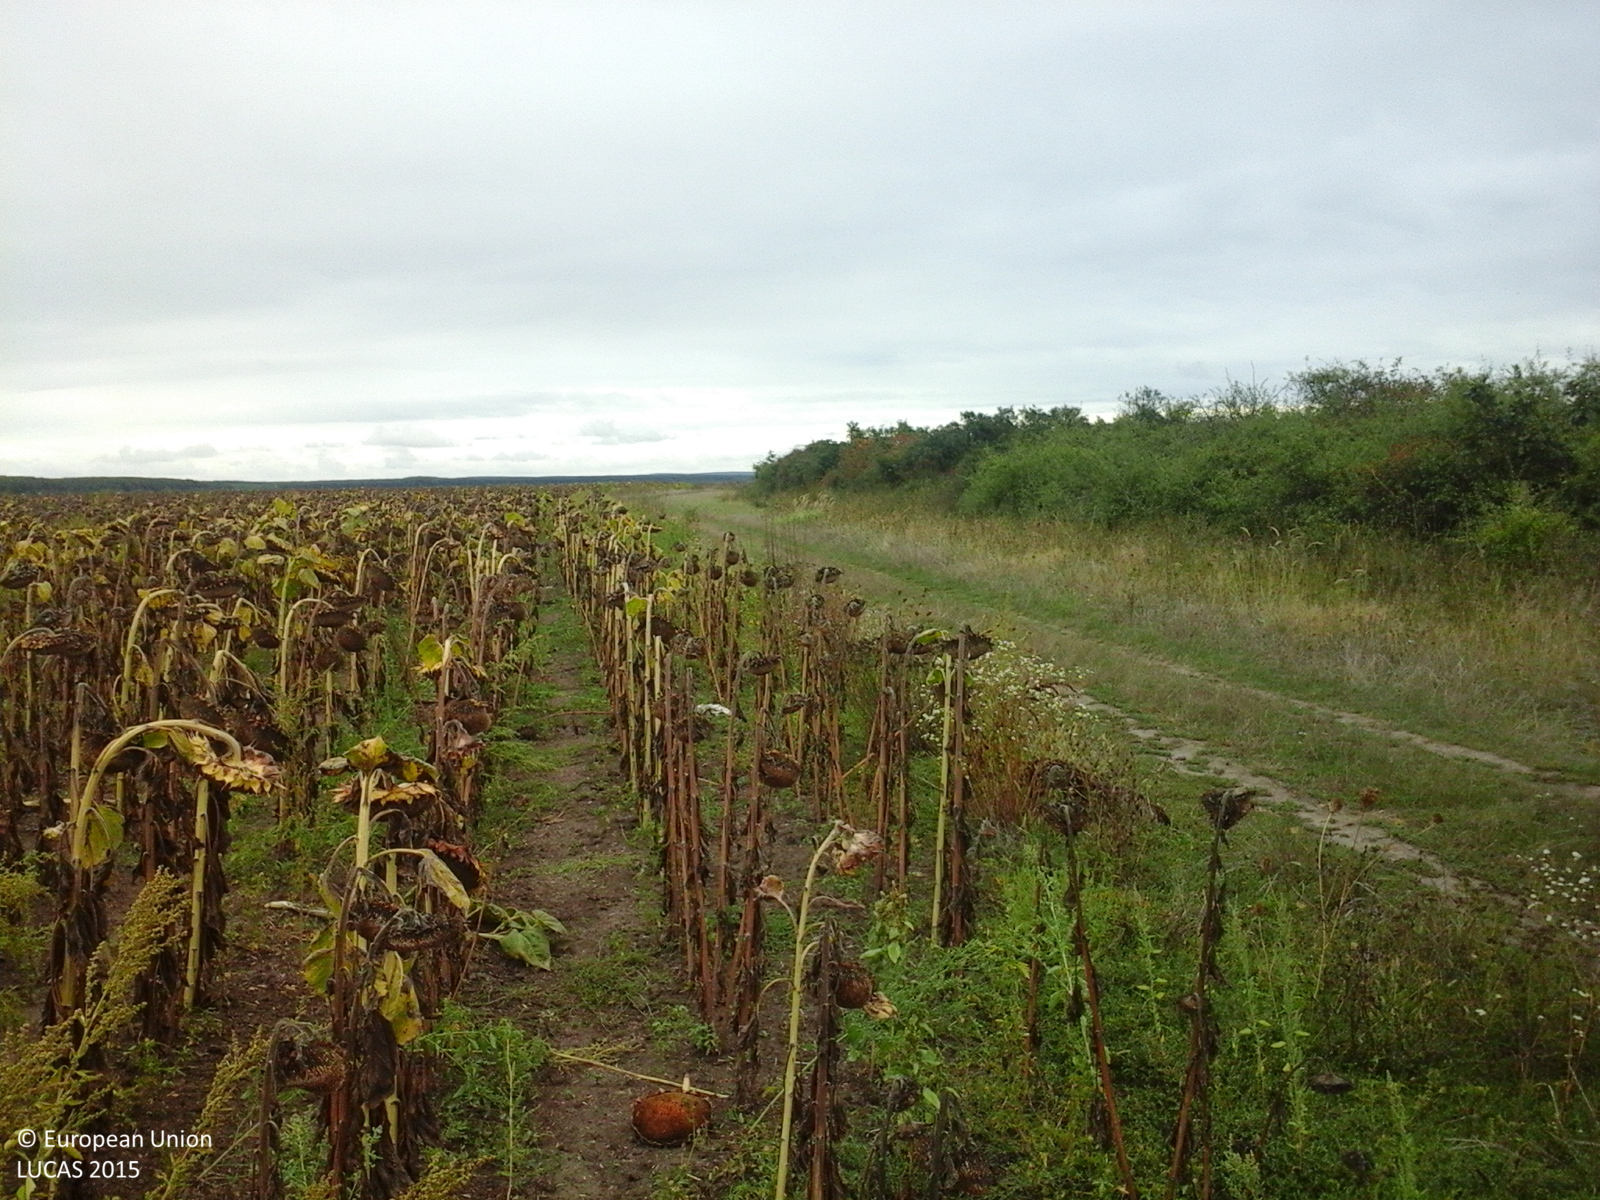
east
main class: Cropland
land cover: Sunflower
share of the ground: > 75 %
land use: Agriculture (excluding fallow land and kitchen gardens)
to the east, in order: Sunflower; Shruby margins; Tracks; Shruby margins; Common wheat
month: September
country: RO
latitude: 46.8353
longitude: 21.8572
